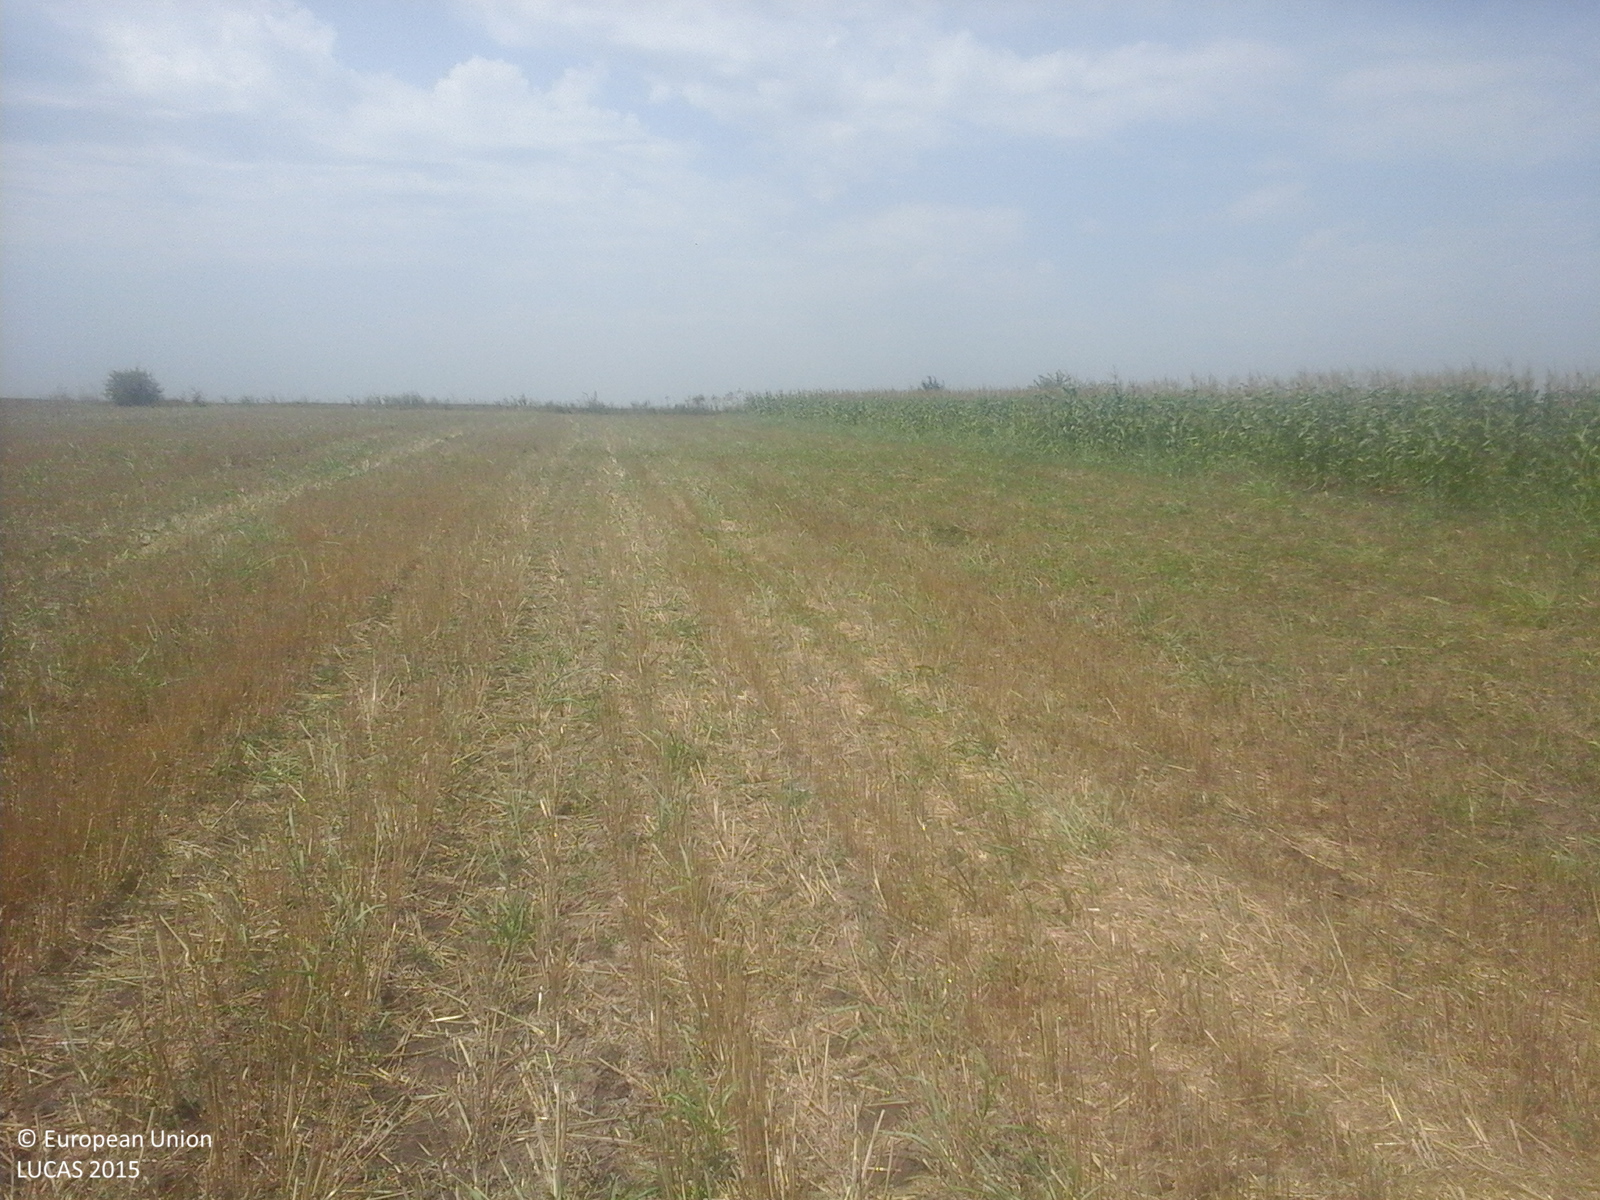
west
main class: Cropland
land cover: Barley
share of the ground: 50 - 75 %
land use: Agriculture (excluding fallow land and kitchen gardens)
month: August
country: RO
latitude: 44.1583
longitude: 28.3328
